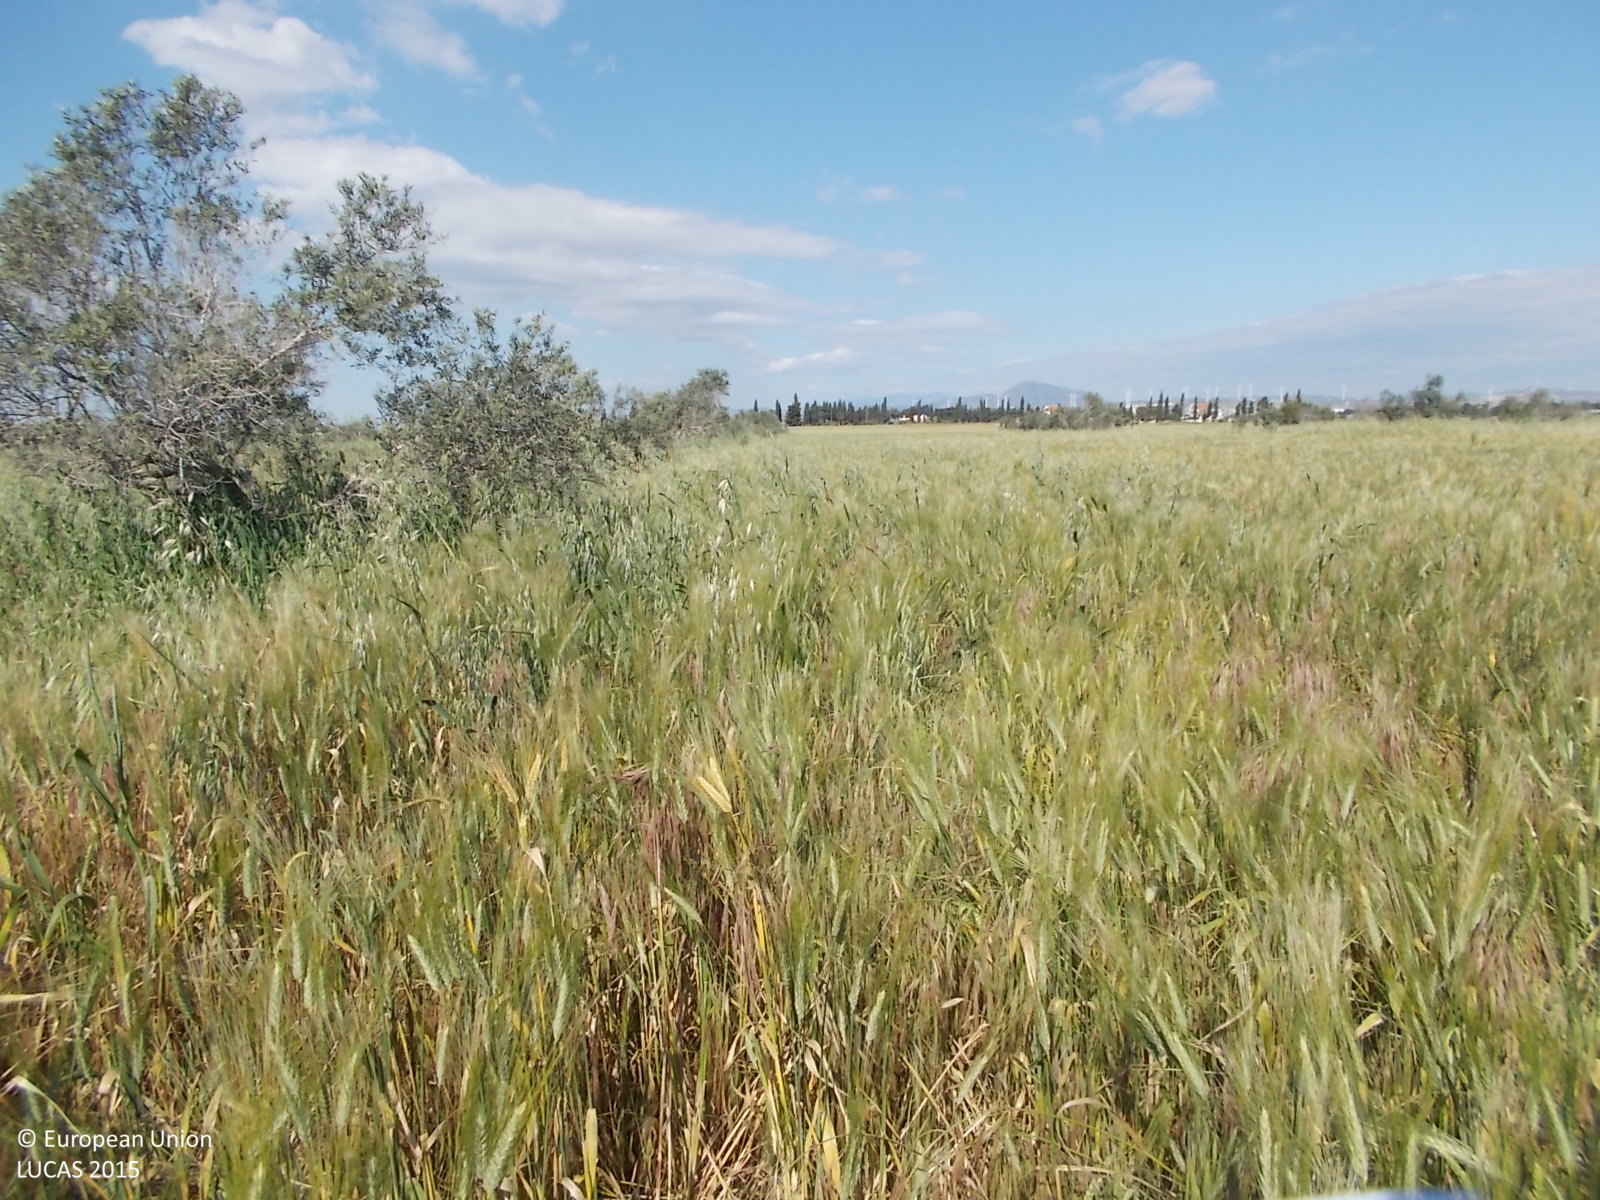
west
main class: Cropland
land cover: Mixed cereals for fodder
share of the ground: > 75 %
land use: Agriculture (excluding fallow land and kitchen gardens)
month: April
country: CY
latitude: 34.8431
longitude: 33.6068
